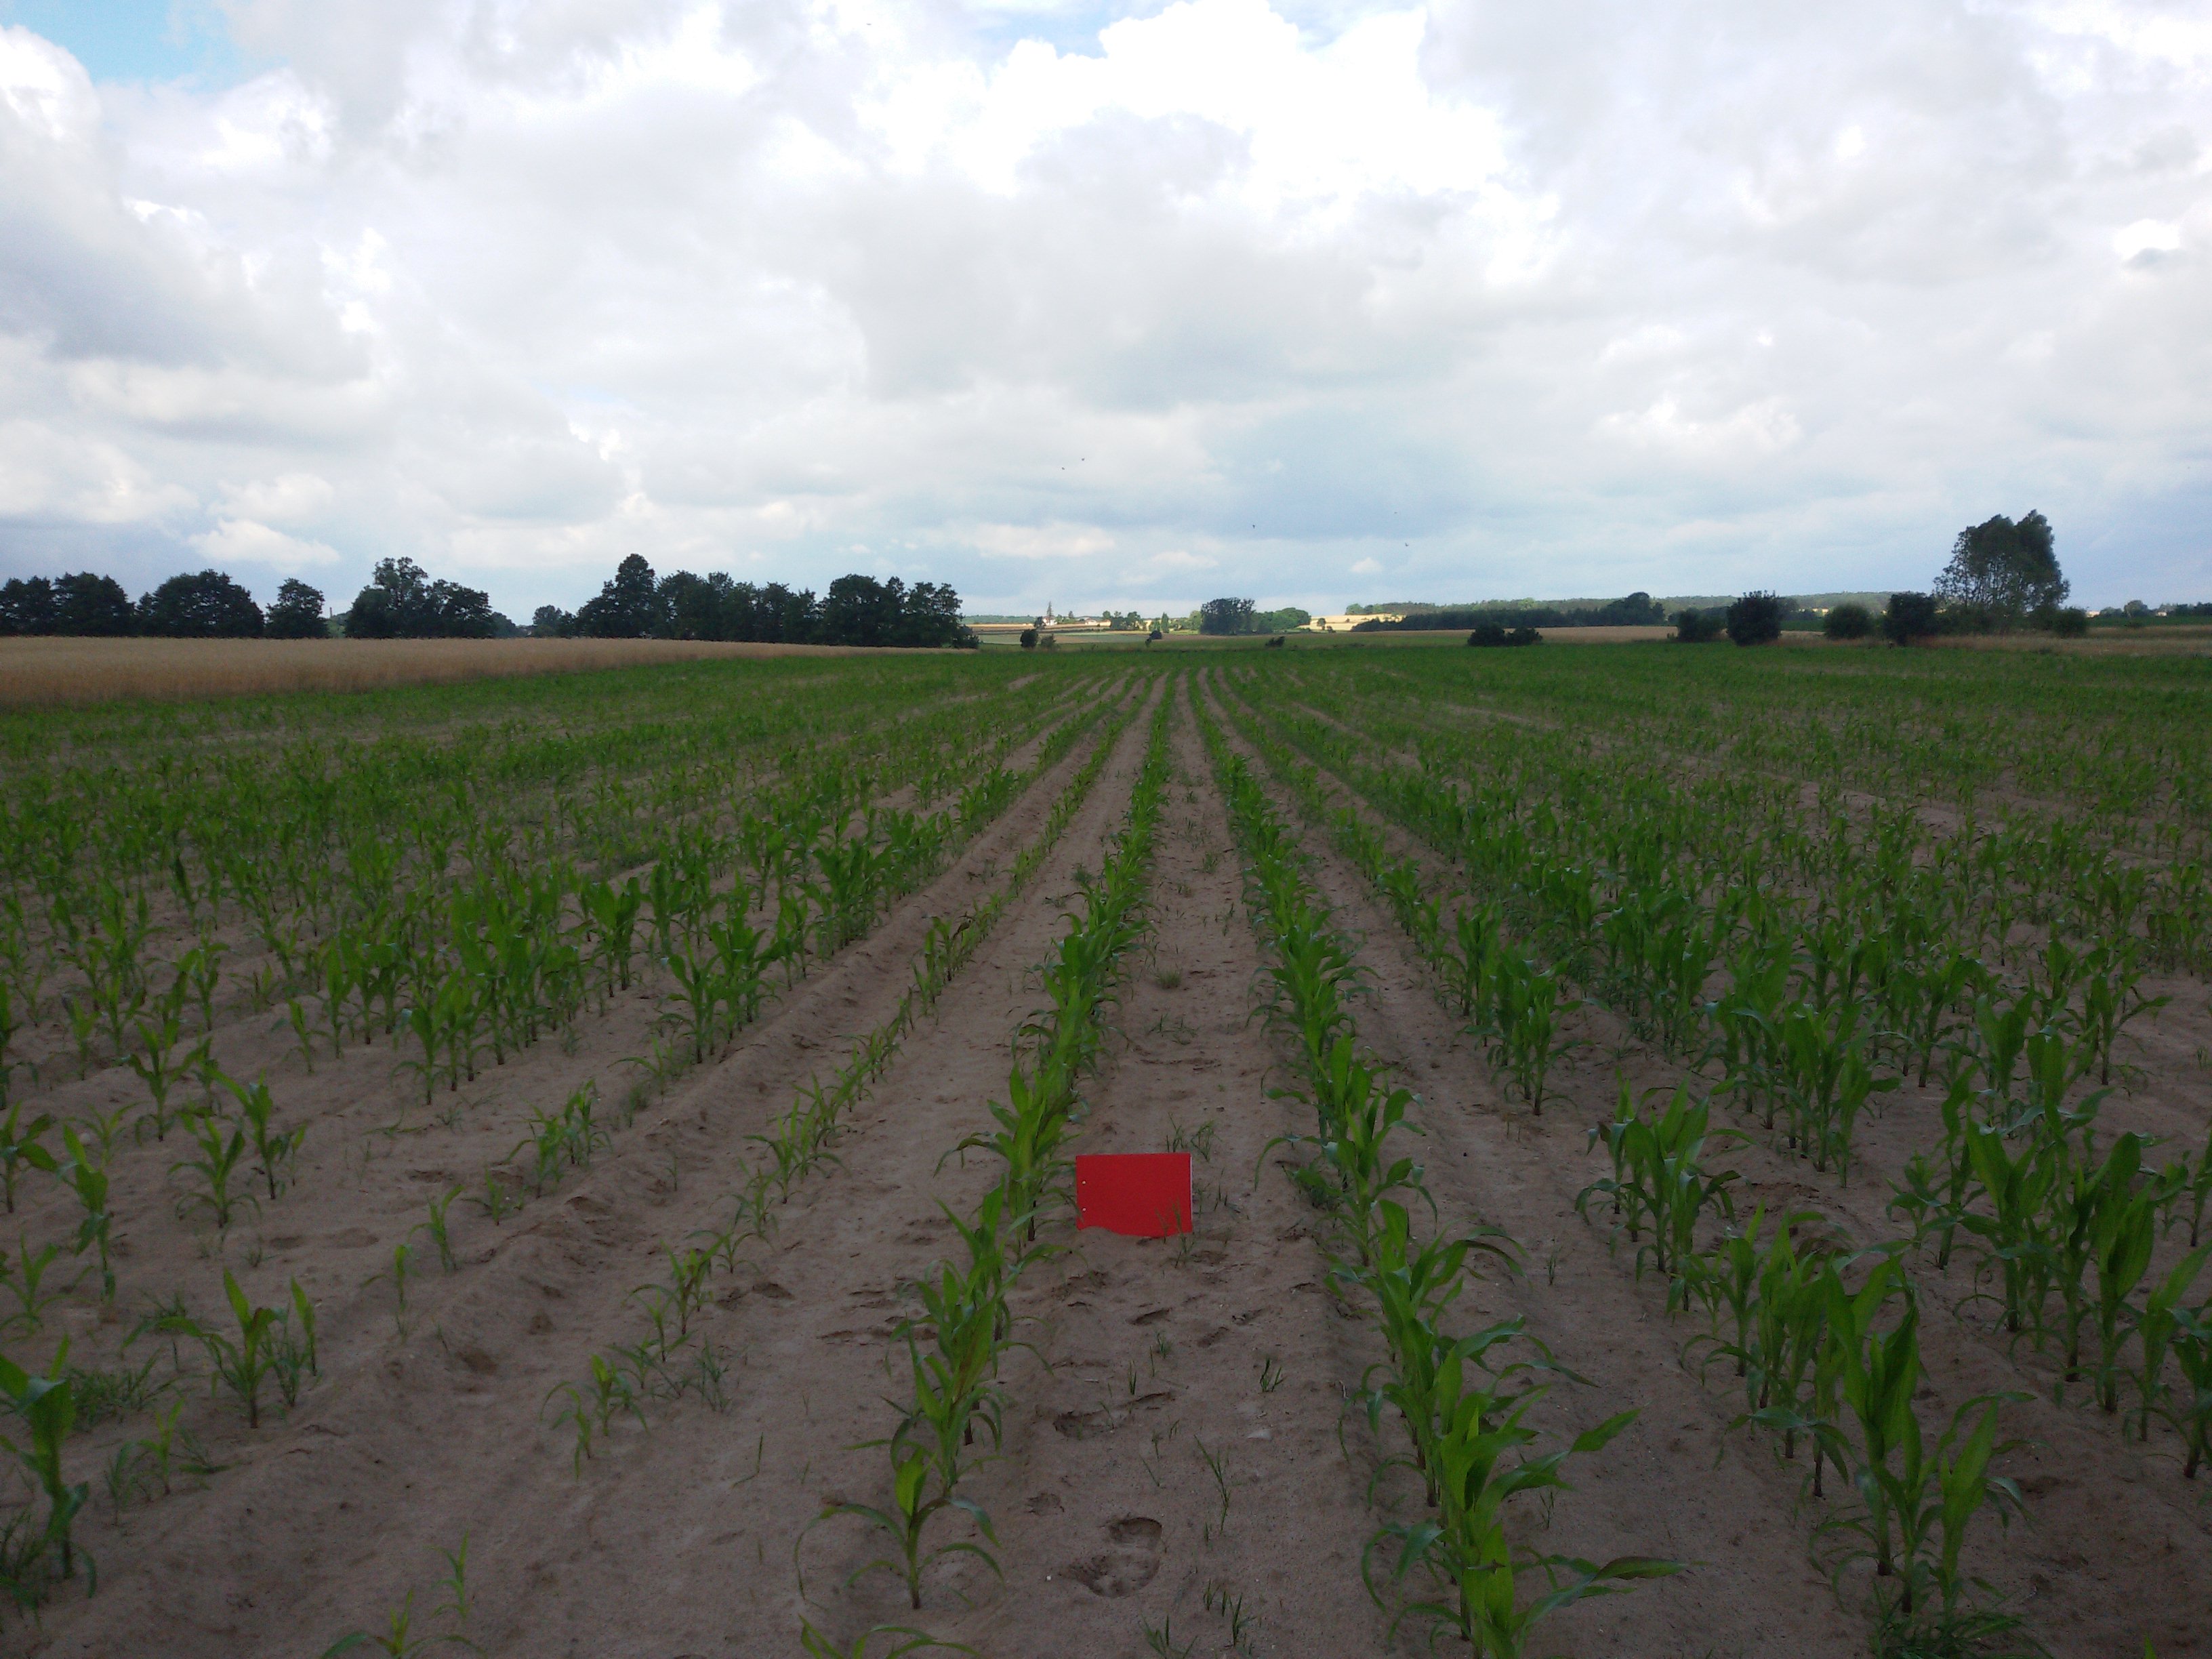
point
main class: Cropland
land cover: Maize
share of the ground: 25 - 50 %
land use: Agriculture (excluding fallow land and kitchen gardens)
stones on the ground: < 10 %
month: July
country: PL
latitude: 52.9612
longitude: 17.6502
